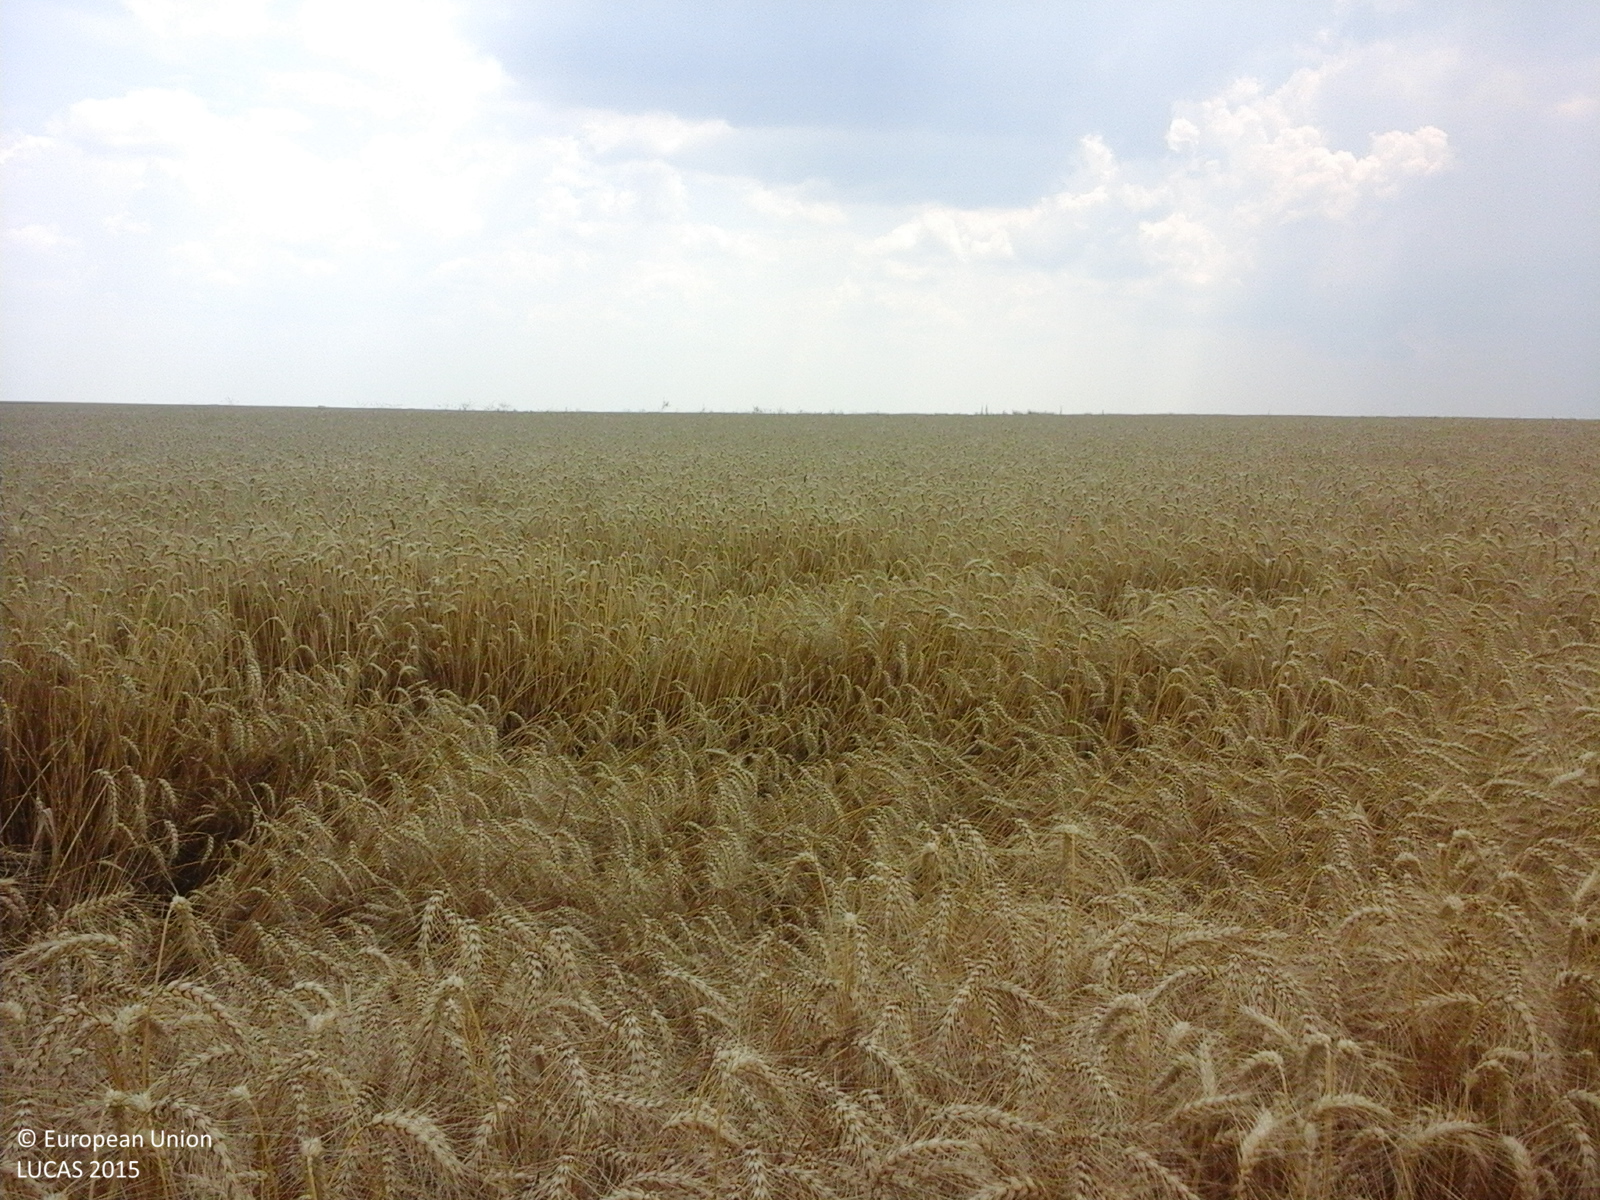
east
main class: Cropland
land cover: Common wheat
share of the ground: > 75 %
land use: Agriculture (excluding fallow land and kitchen gardens)
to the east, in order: Common wheat; Grass margins; Common wheat; Rape and turnip rape
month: July
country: RO
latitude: 43.9427
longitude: 25.1669
